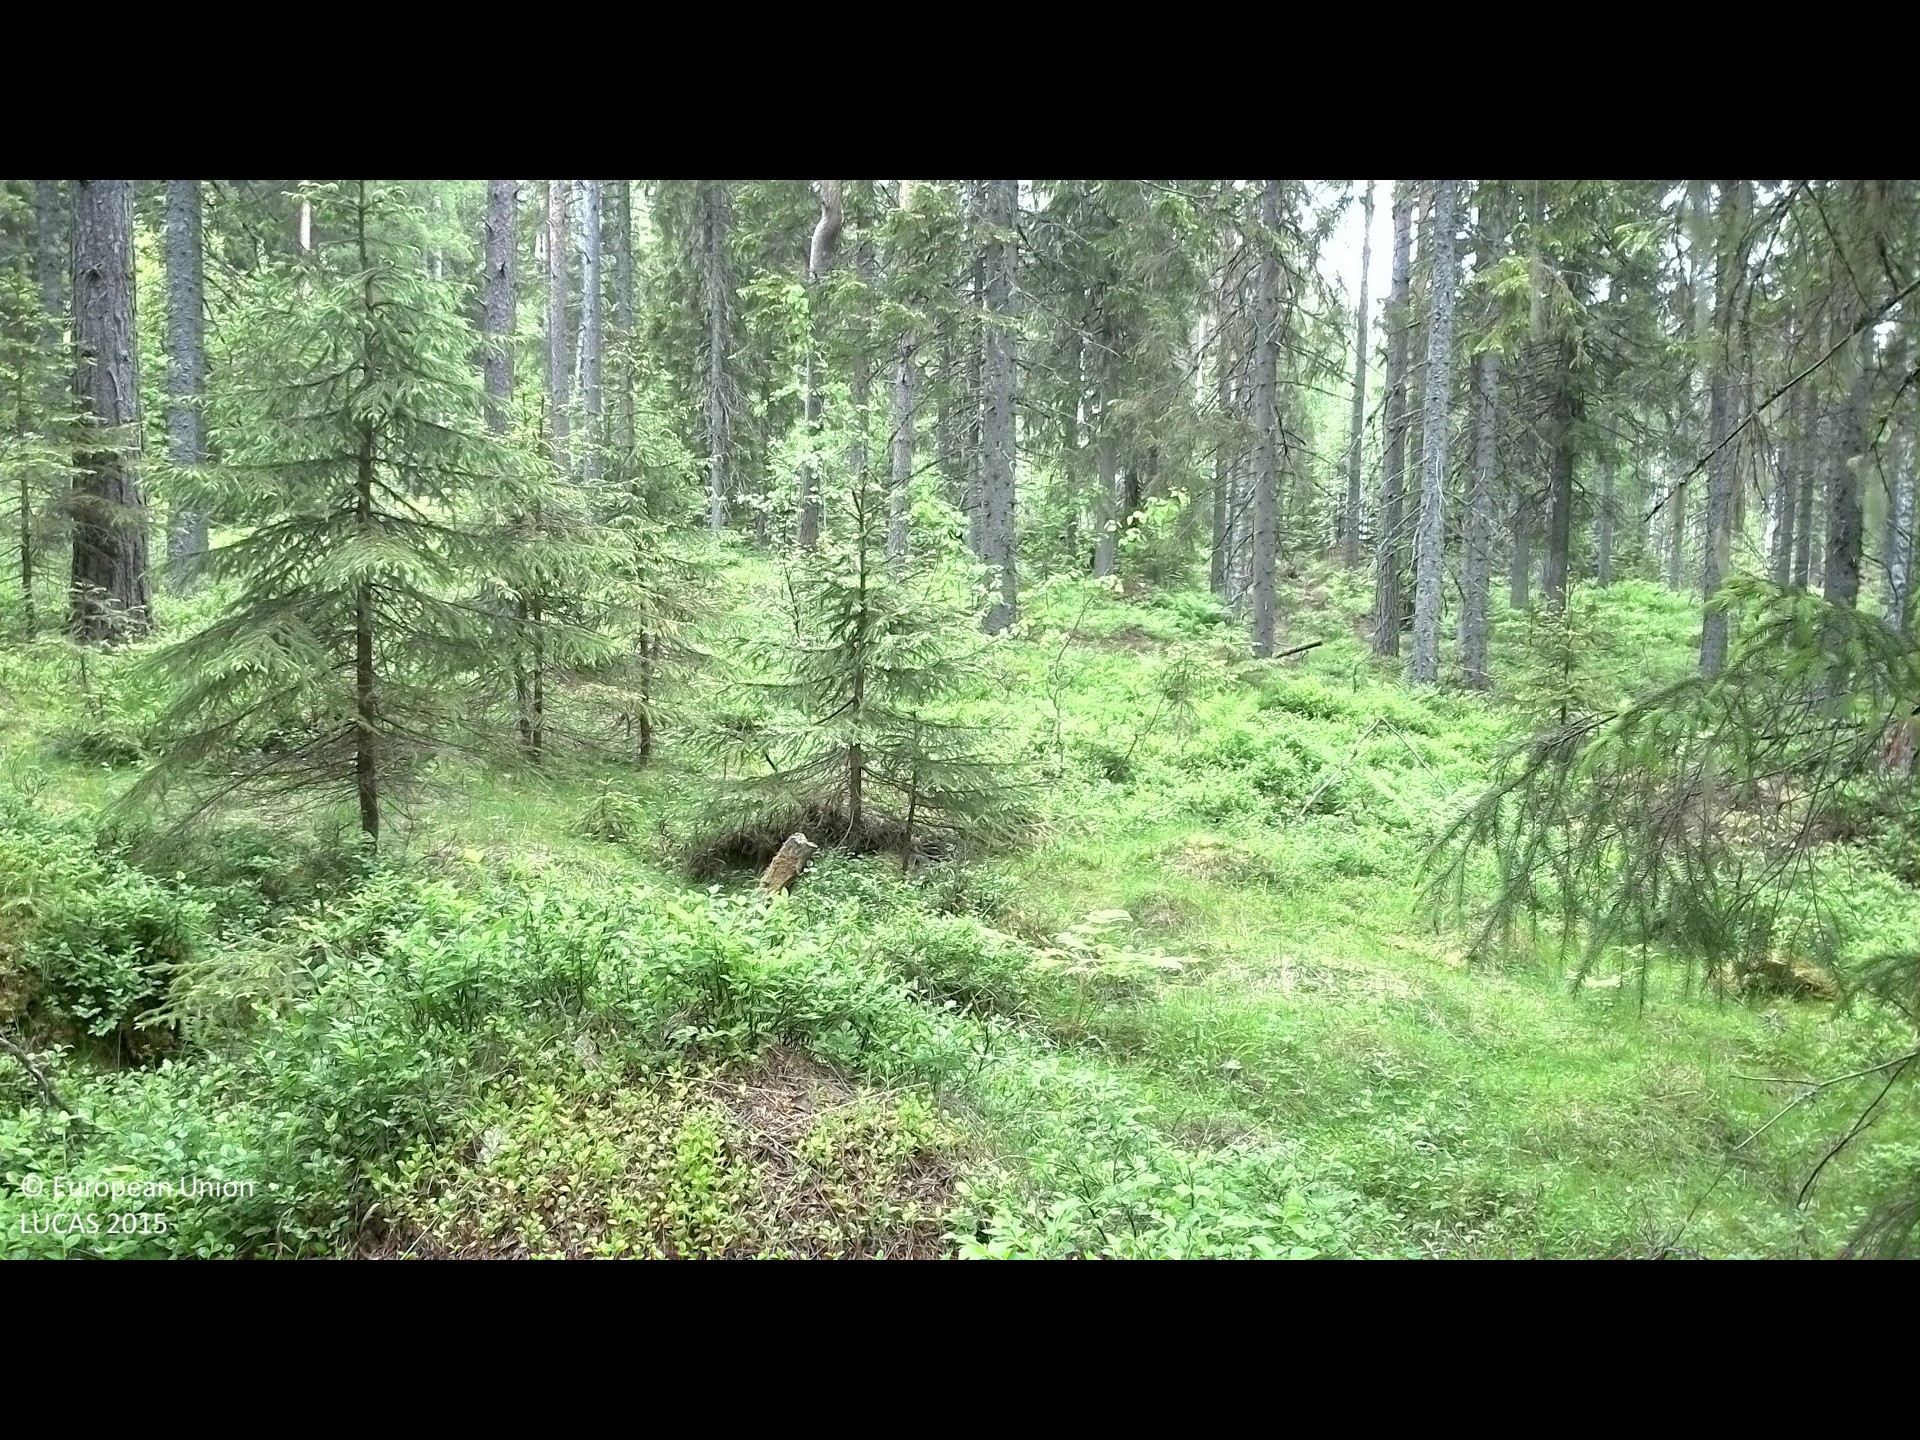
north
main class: Woodland
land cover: Spruce dominated coniferous woodland
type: boreal forest
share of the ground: 25 - 50 %
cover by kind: shrubs 40 %, coniferous forest trees 35 %, herbaceous plants 15 %, broadleaved forest trees 5 %, lichens and mosses 5 %
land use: Forestry
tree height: > 5 m
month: June
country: SE
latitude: 61.9472
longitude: 16.9014
